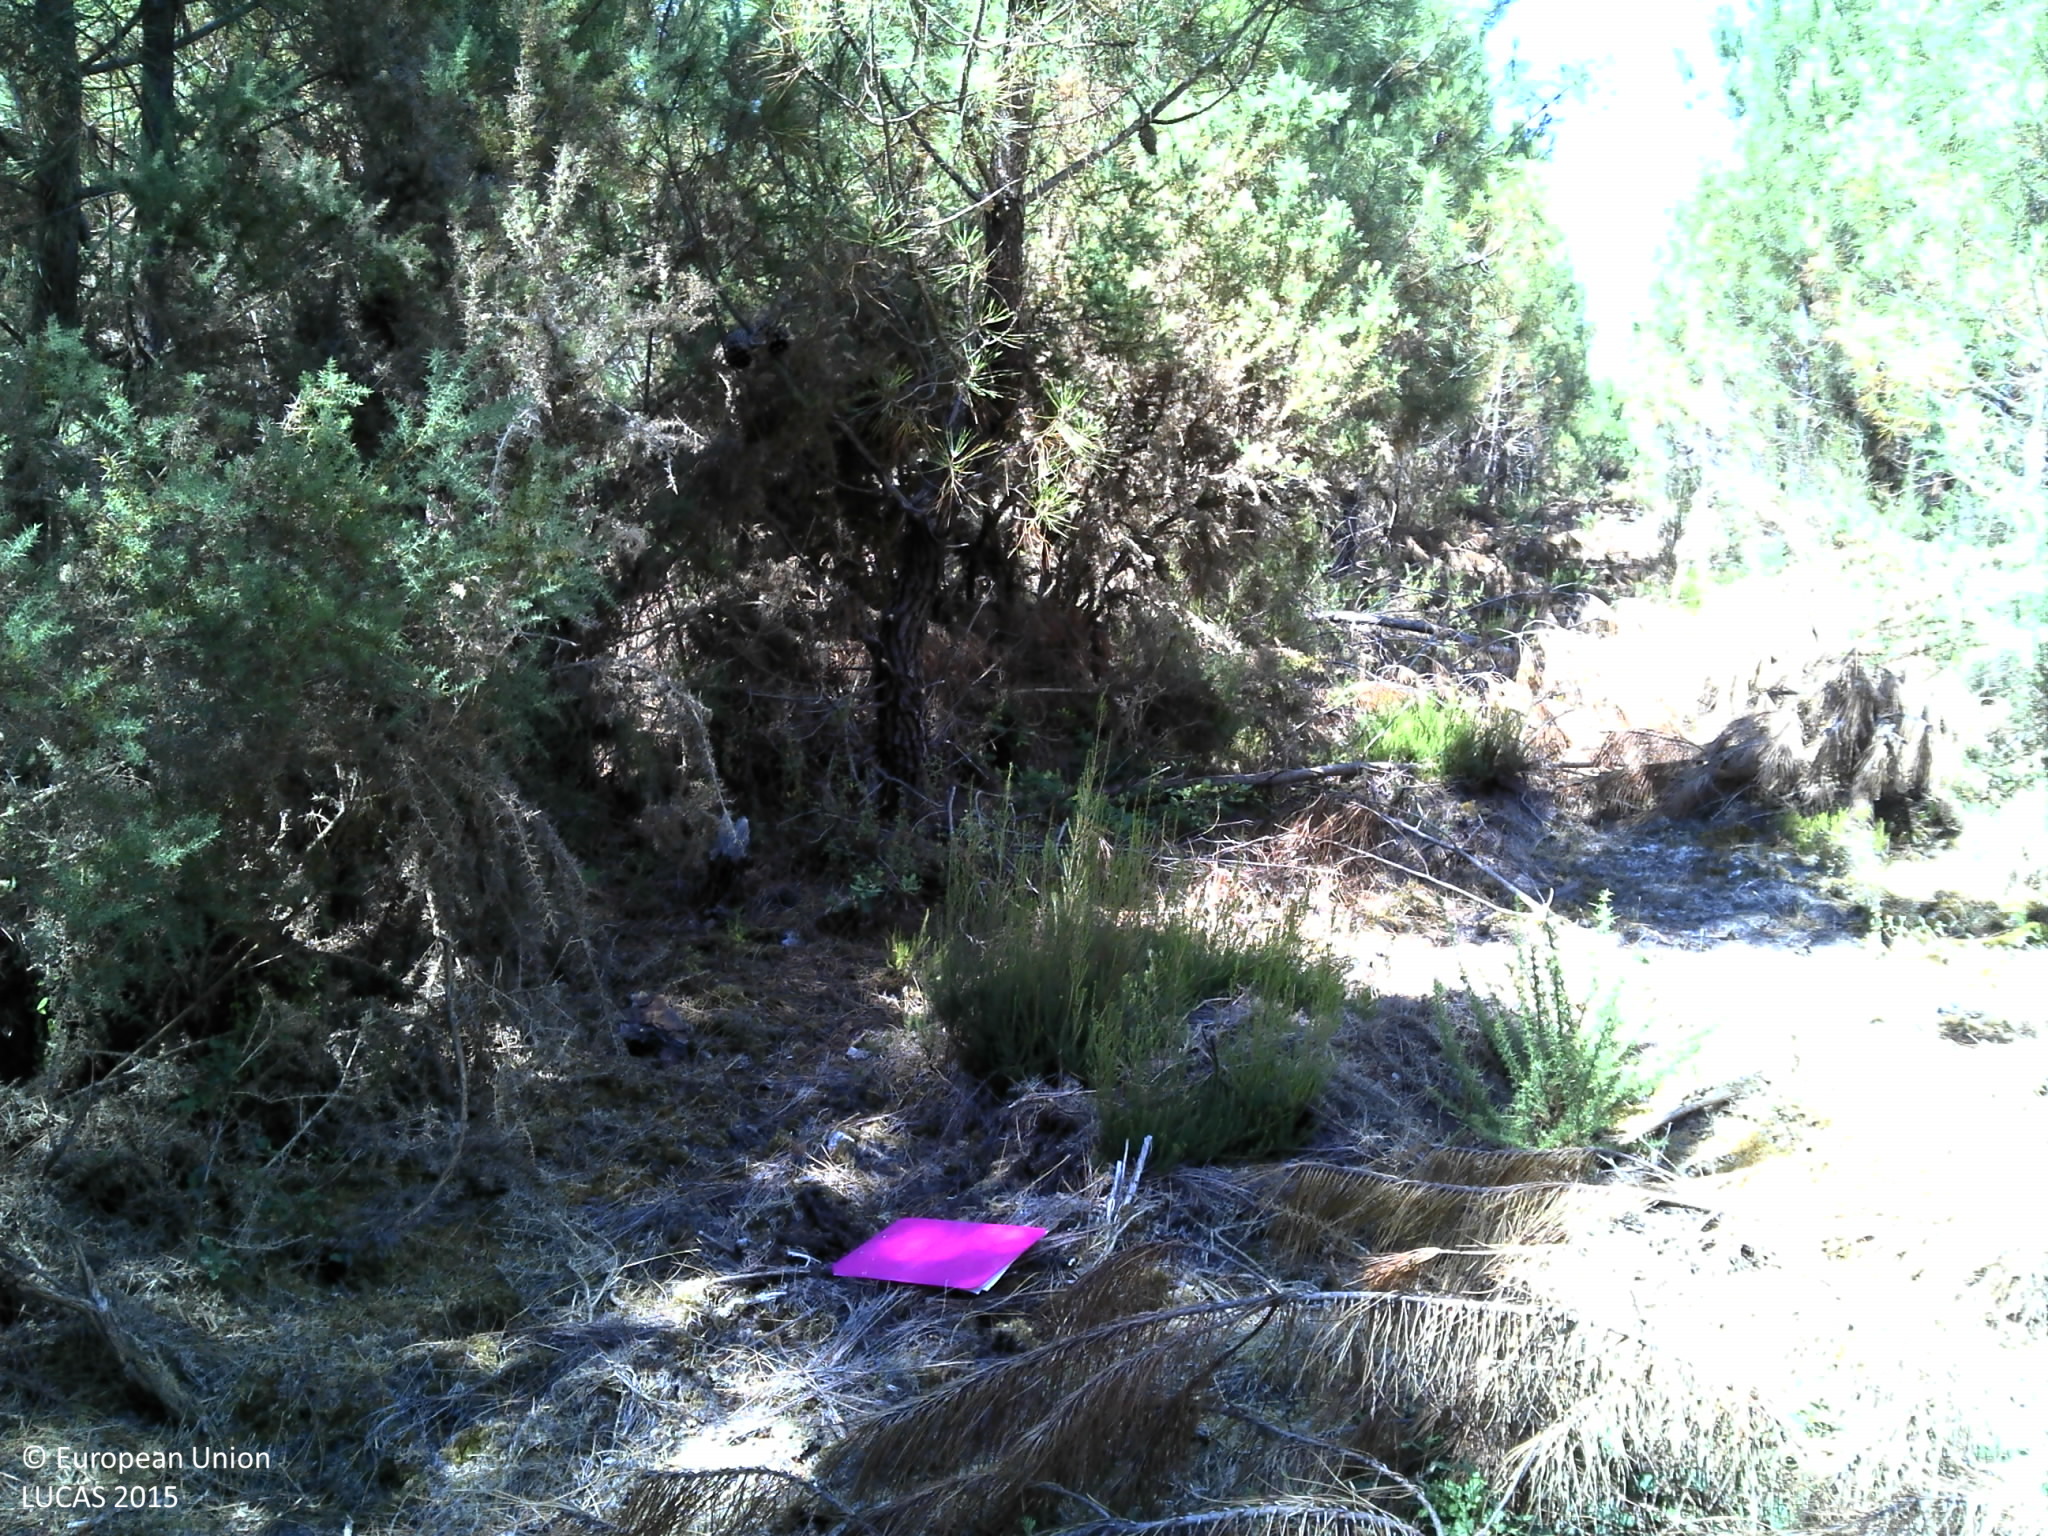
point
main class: Woodland
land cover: Pine dominated coniferous woodland
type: coniferous forest of the mediterranean region
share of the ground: > 75 %
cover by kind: coniferous forest trees 75 %, shrubs 15 %, unconsolidated bare surface 10 %
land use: Forestry
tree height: < 5 m
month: July
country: FR
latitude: 45.2954
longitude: -1.1335
